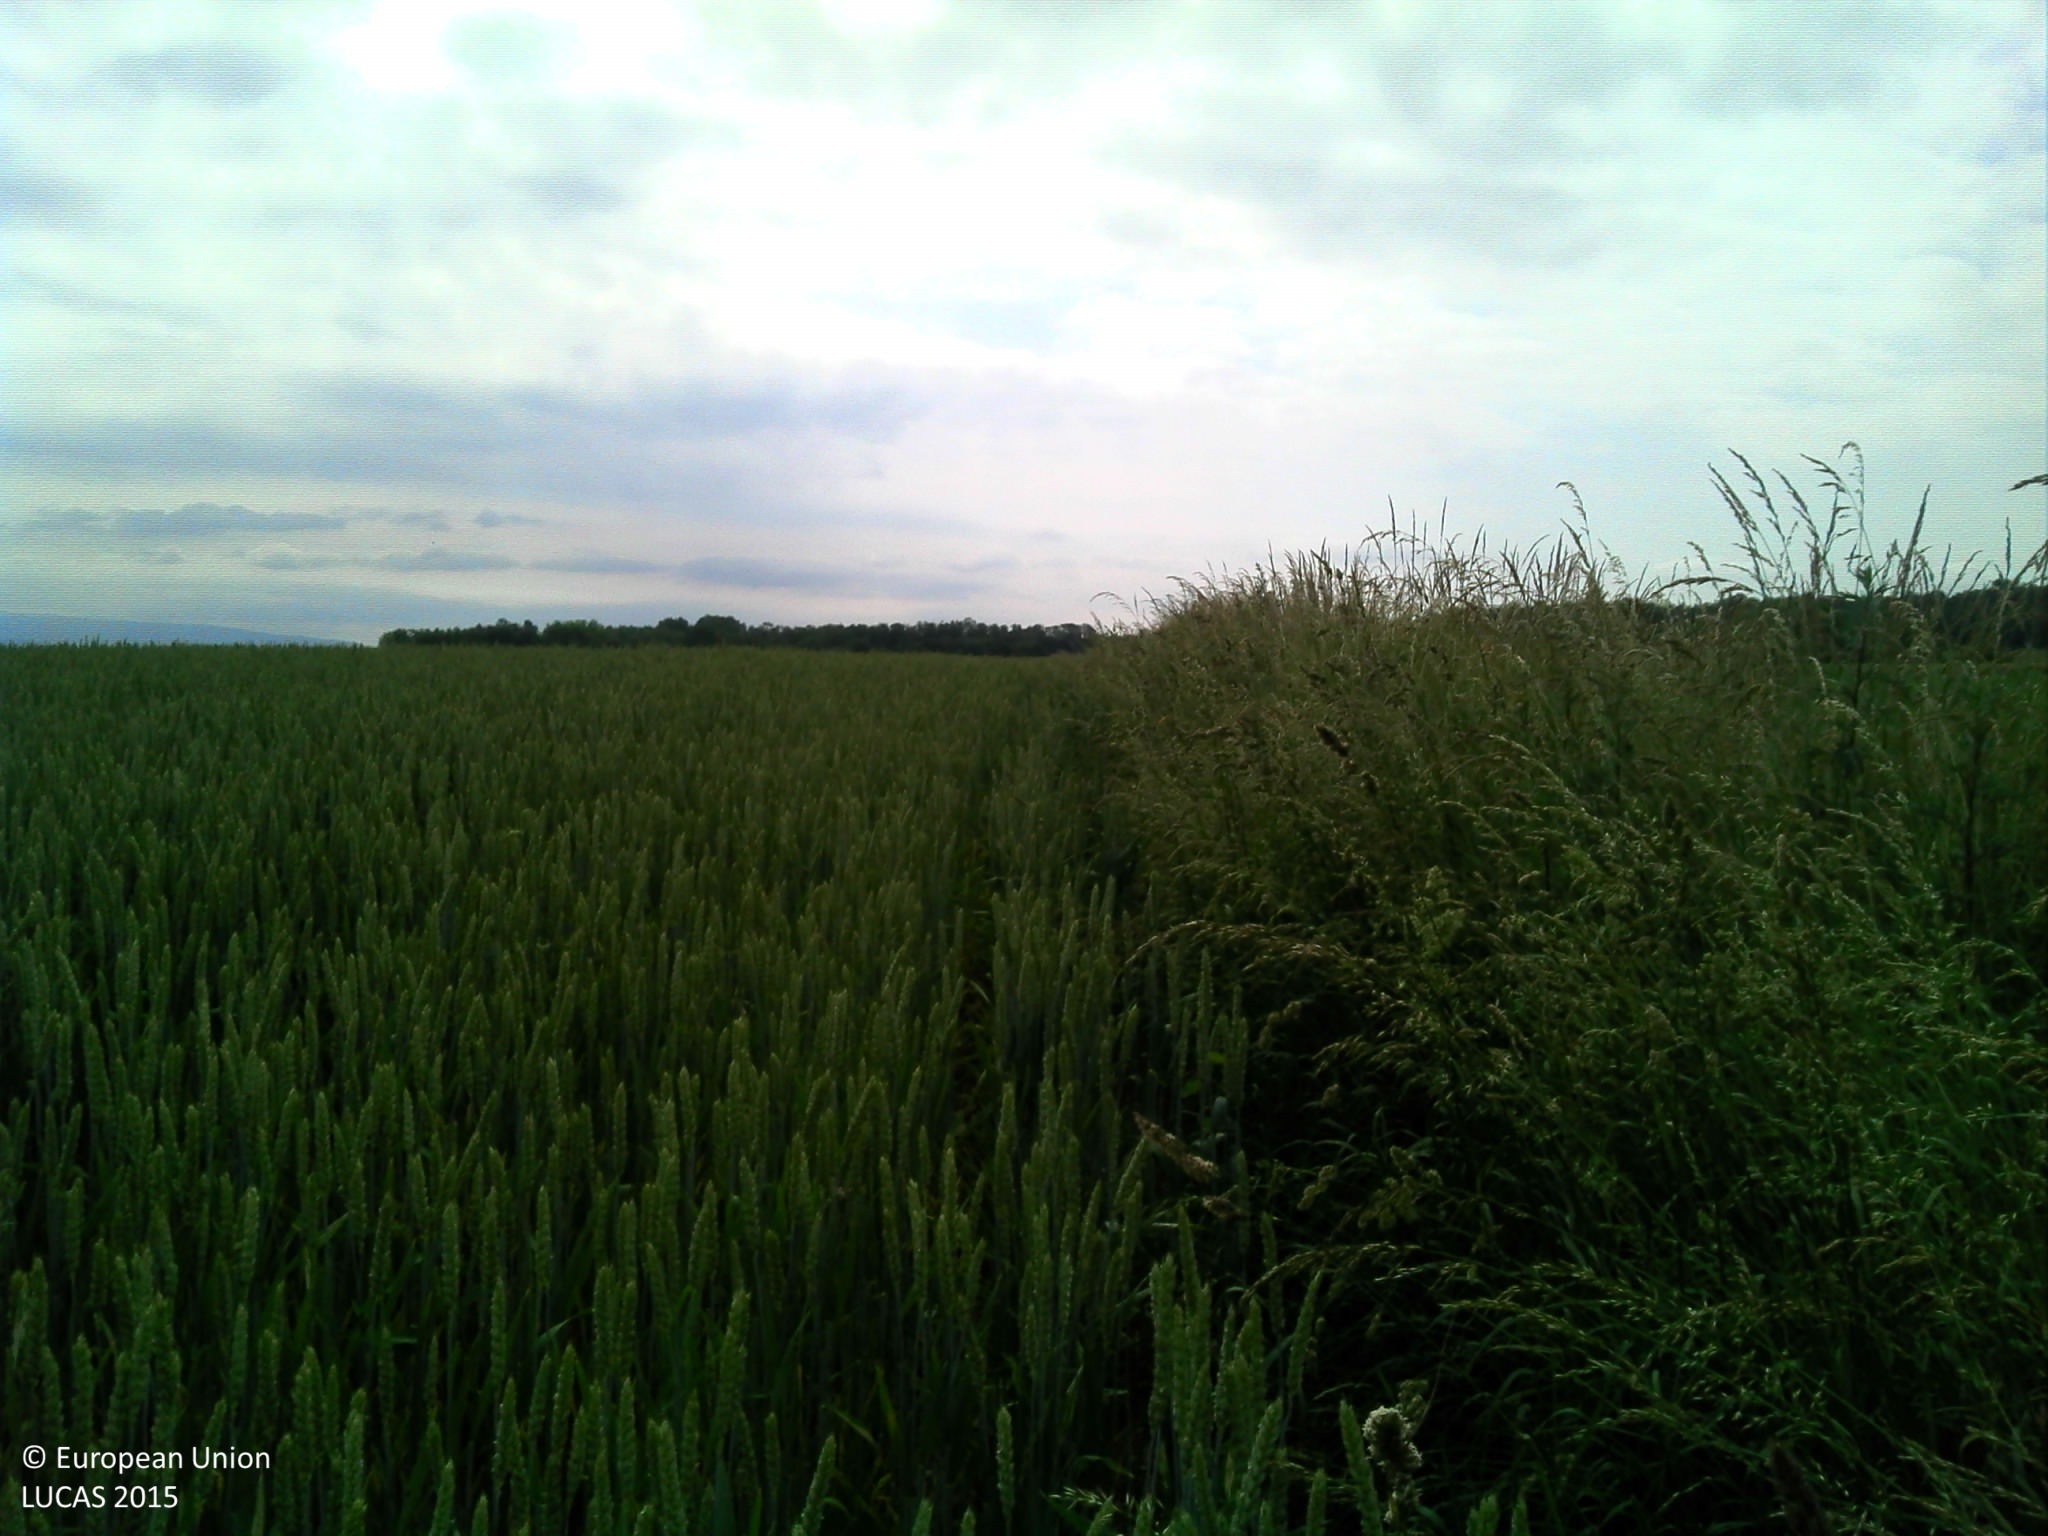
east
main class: Cropland
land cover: Common wheat
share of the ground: > 75 %
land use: Agriculture (excluding fallow land and kitchen gardens)
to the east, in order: Common wheat; Grass margins; Rape and turnip rape
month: June
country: FR
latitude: 47.7491
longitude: 6.3599
